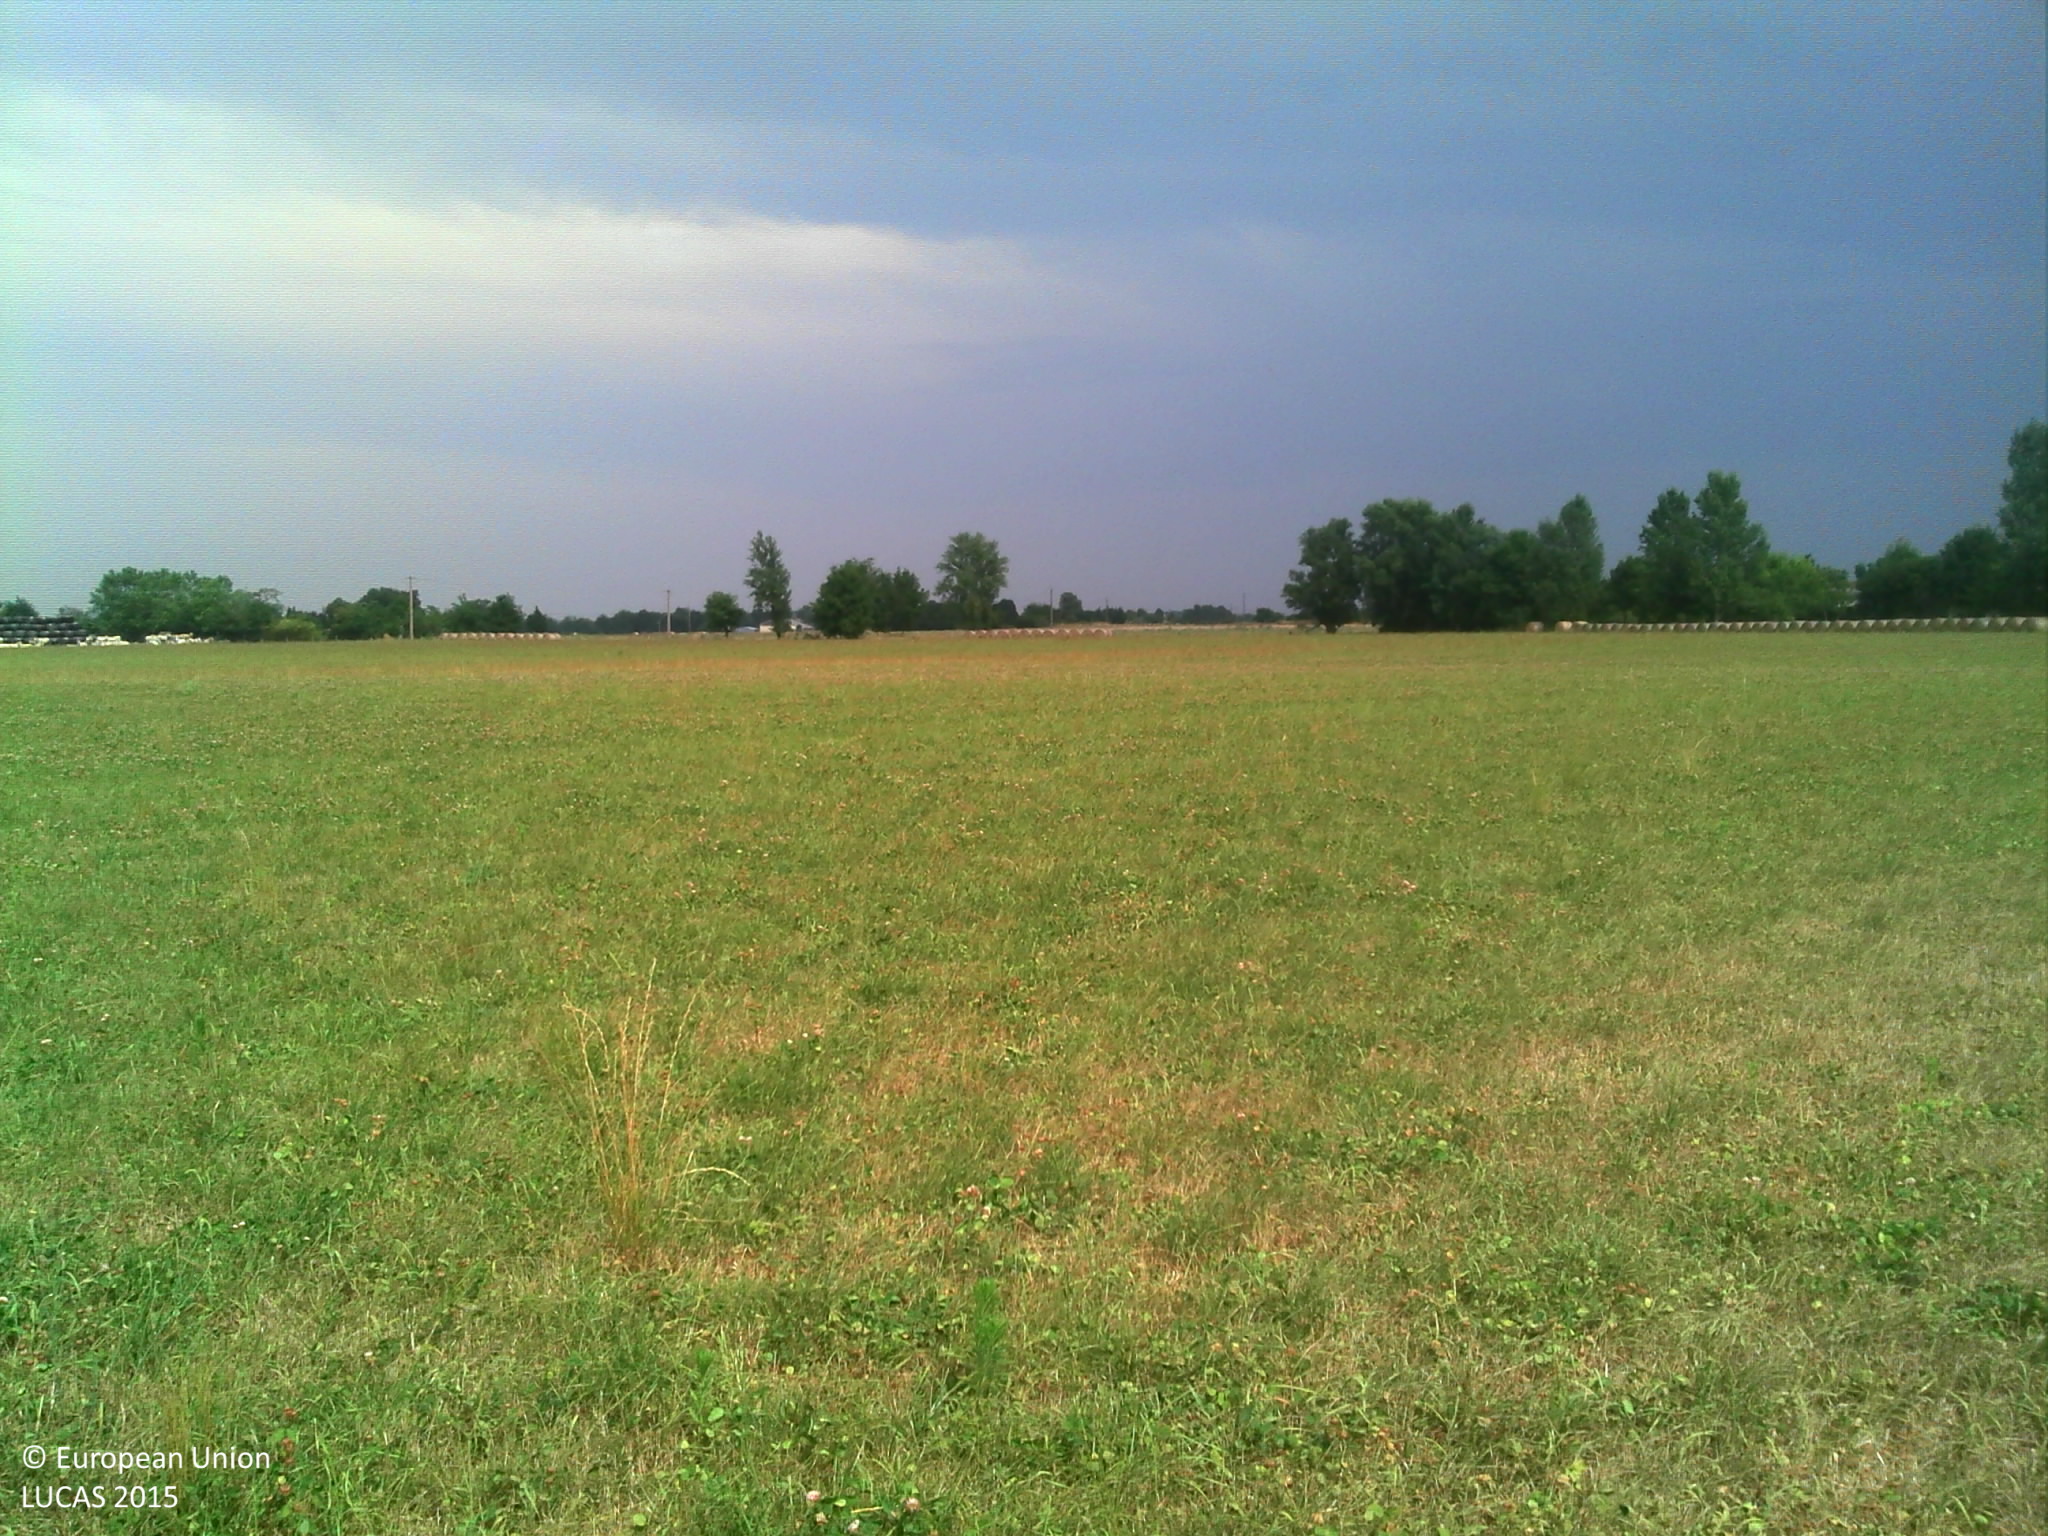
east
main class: Grassland
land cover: Grassland without tree/shrub cover
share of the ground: > 75 %
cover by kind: herbaceous plants 100 %
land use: Agriculture (excluding fallow land and kitchen gardens)
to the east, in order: Grassland without tree/shrub cover
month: July
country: FR
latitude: 43.2754
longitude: 1.0693
